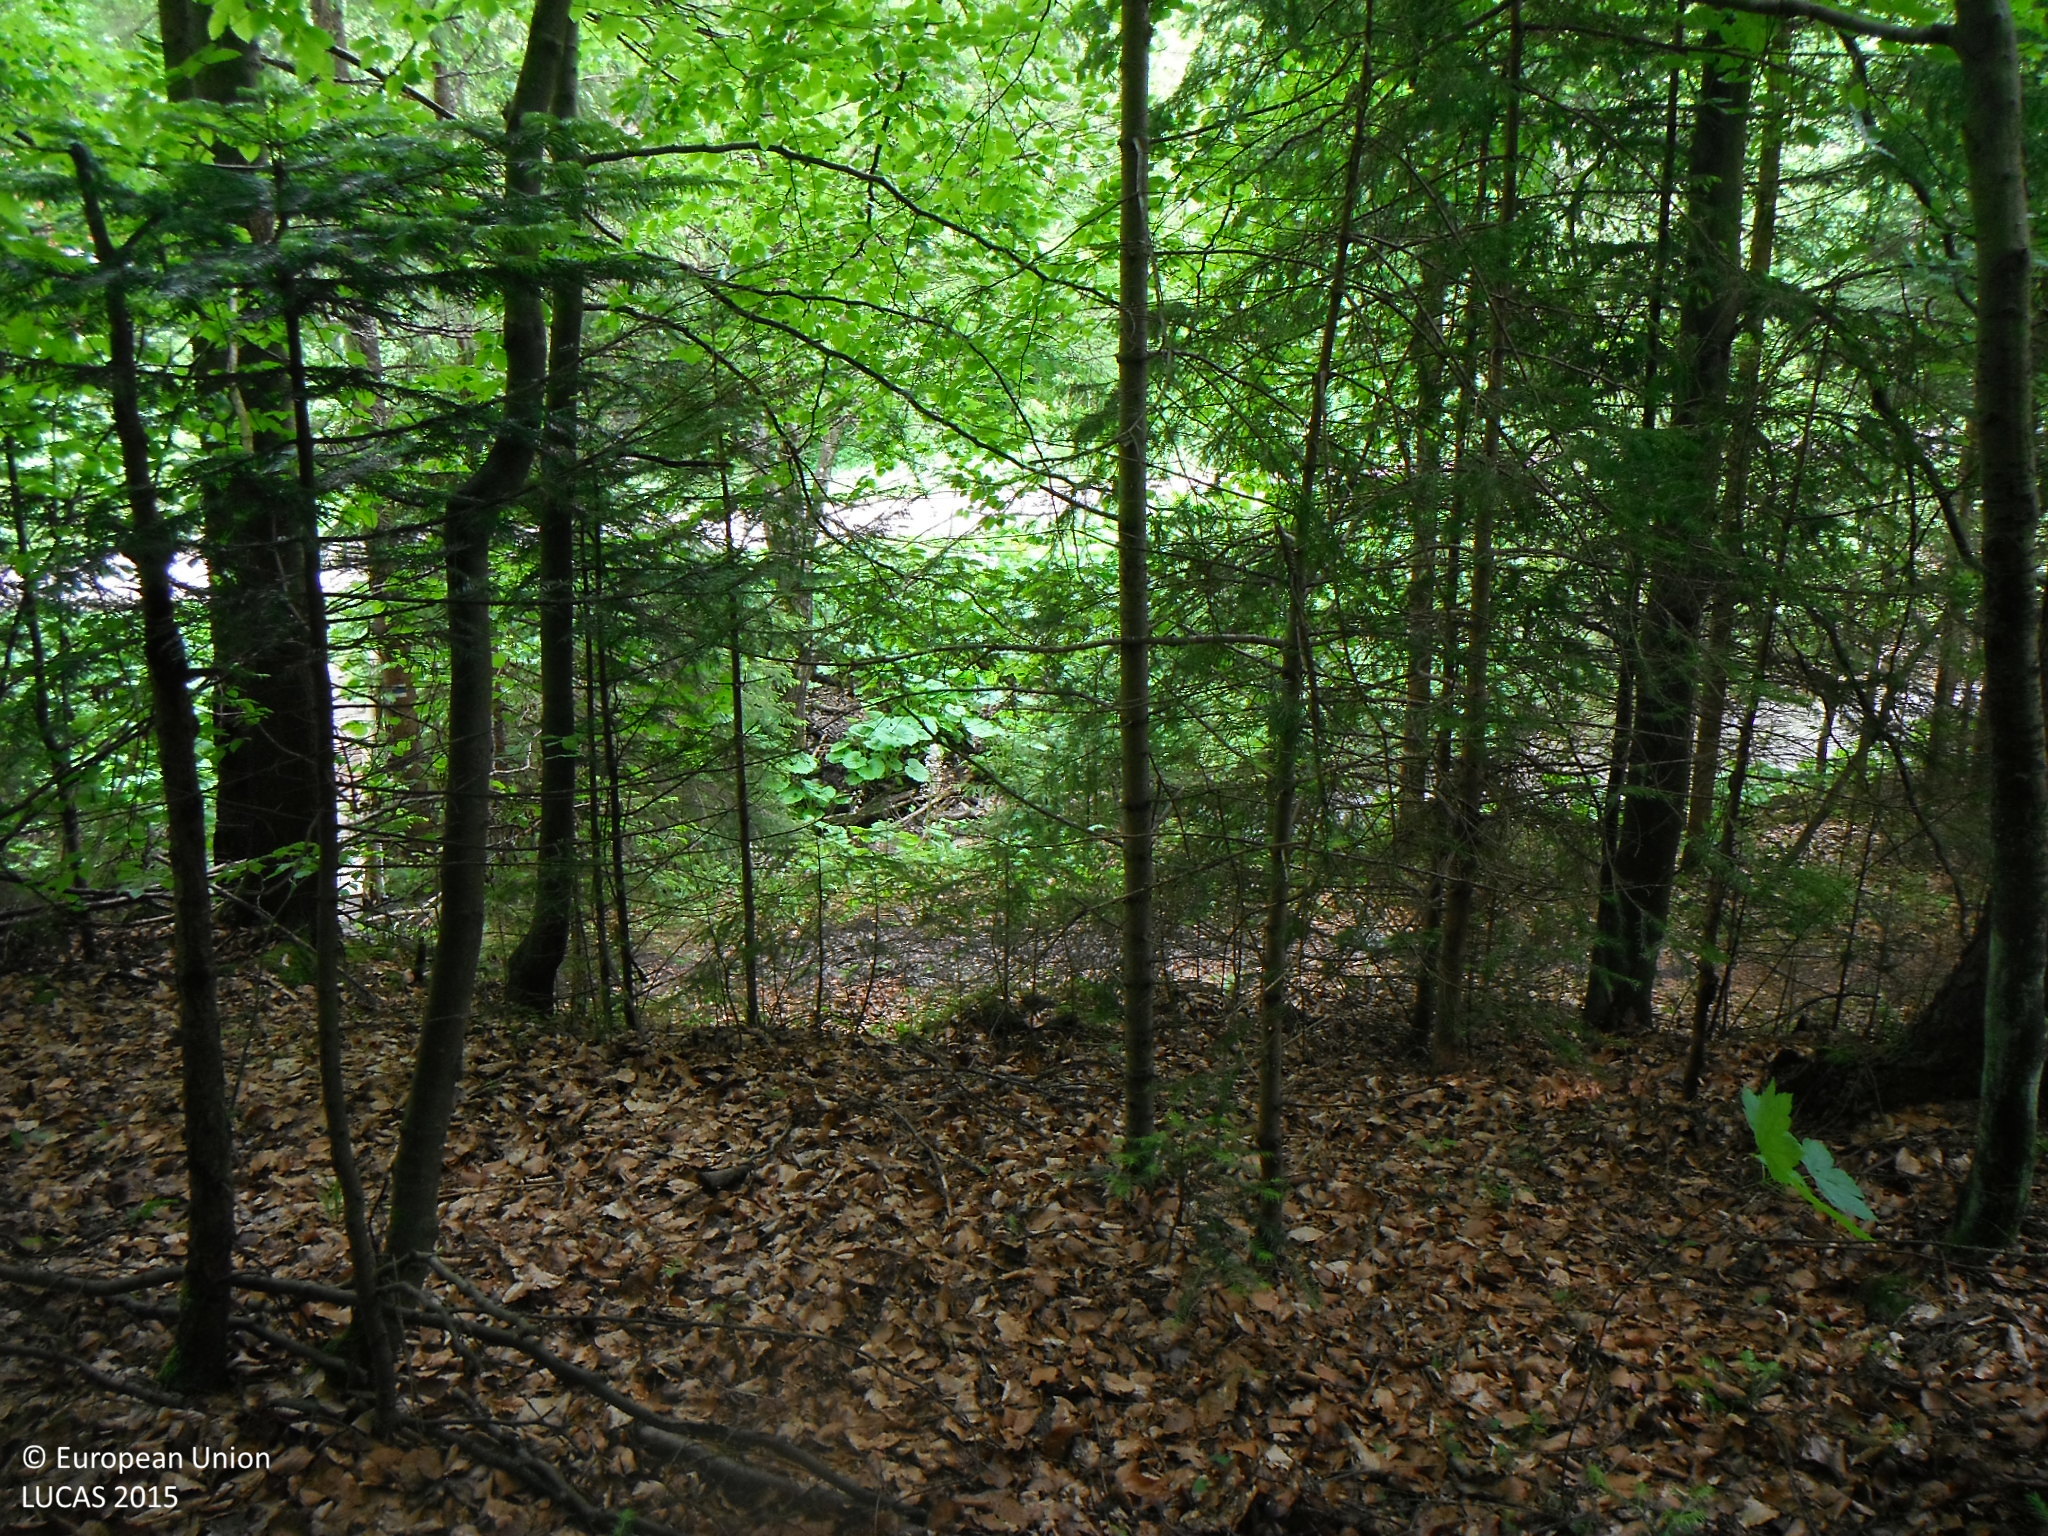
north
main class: Woodland
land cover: Spruce dominated mixed woodland
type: hemiboreal forest and nemoral coniferous forest and mixed broadleaved-coniferous forest
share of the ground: > 75 %
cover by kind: coniferous forest trees 70 %, broadleaved forest trees 30 %
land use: Forestry
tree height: > 5 m
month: May
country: SK
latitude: 49.0086
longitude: 19.0588
